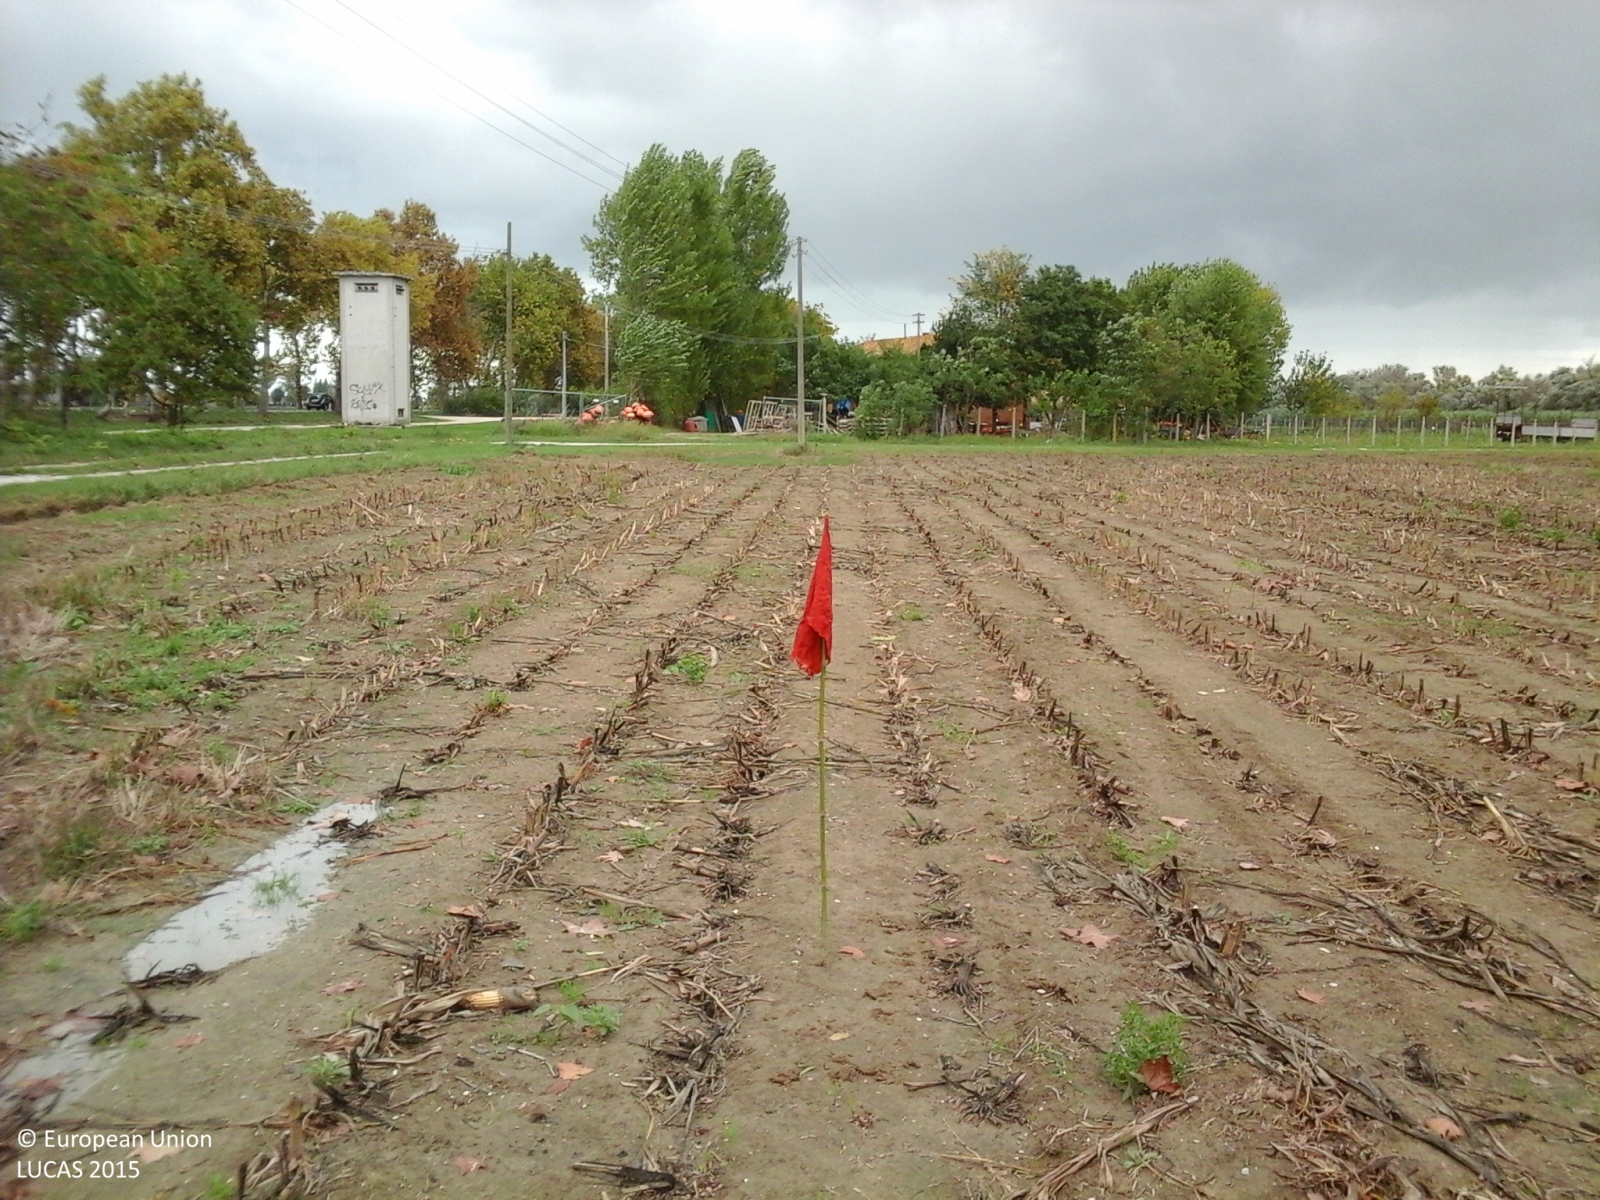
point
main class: Cropland
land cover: Maize
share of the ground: < 10 %
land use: Agriculture (excluding fallow land and kitchen gardens)
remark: Harvested field
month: October
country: IT
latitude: 43.6284
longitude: 13.3507
